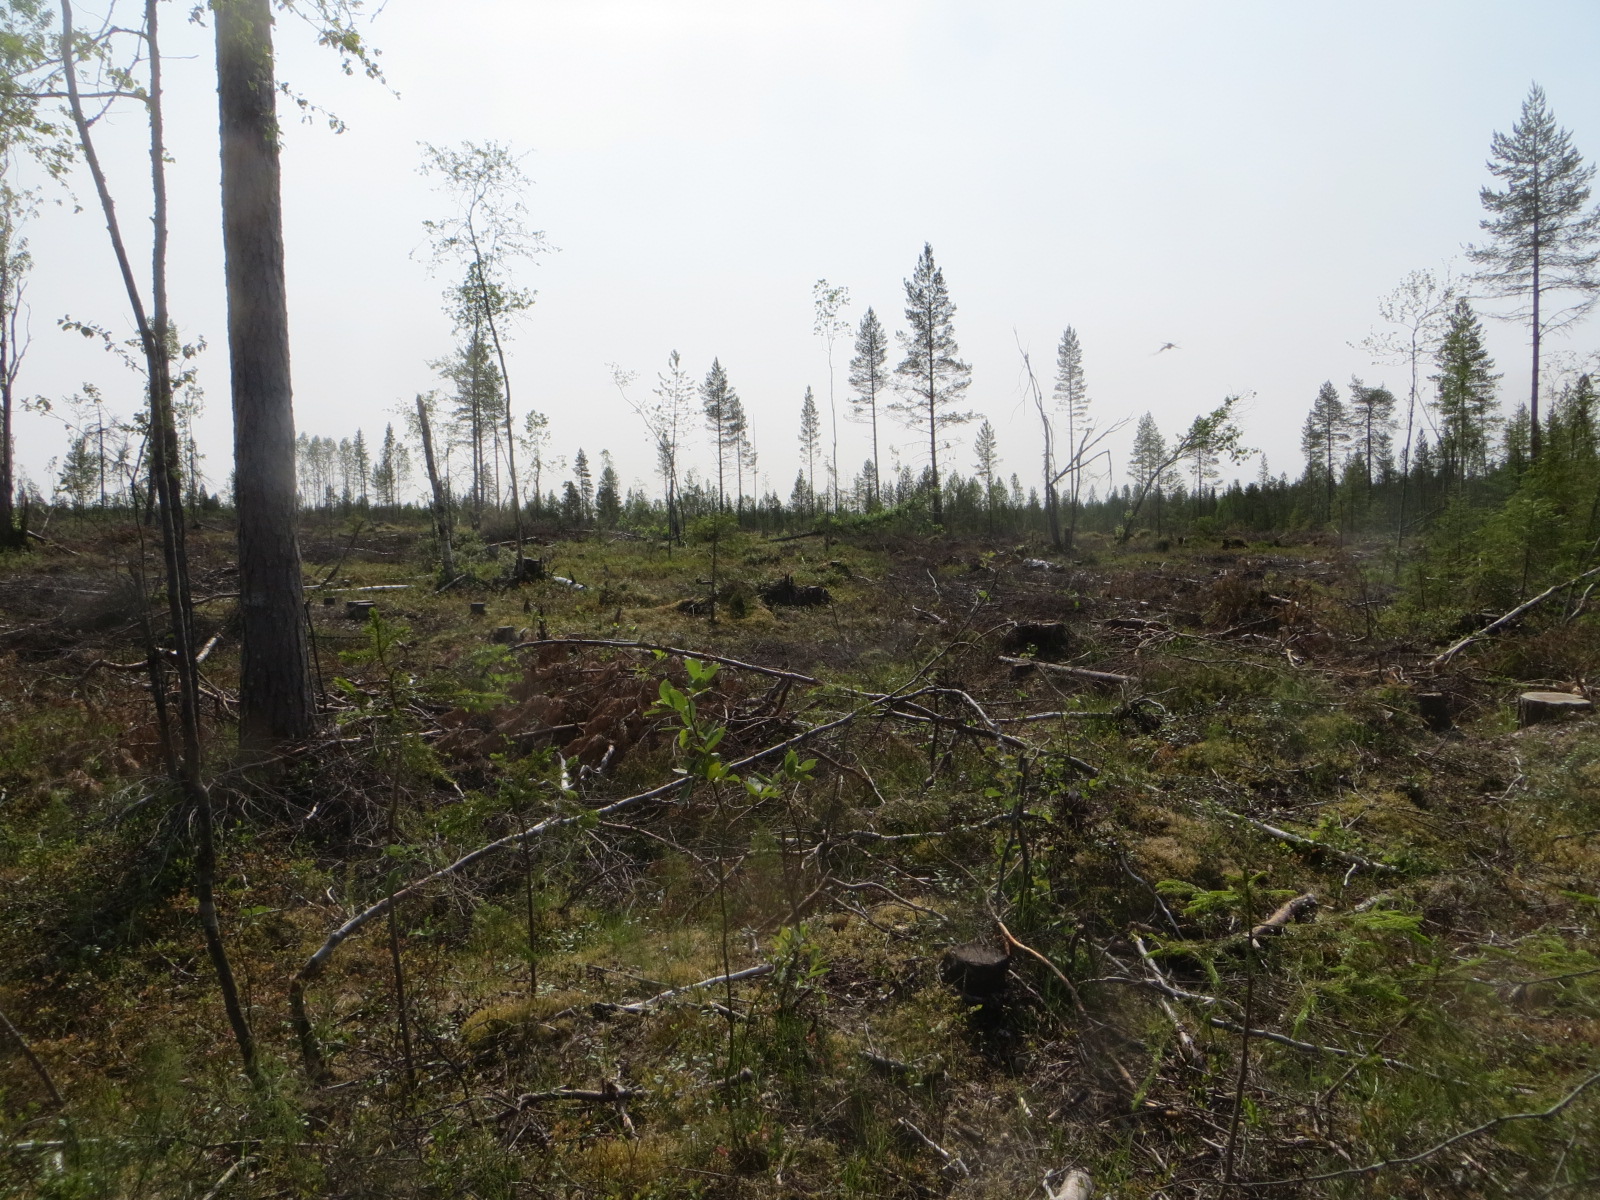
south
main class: Woodland
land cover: Pine dominated mixed woodland
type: boreal forest
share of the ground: 10 - 25 %
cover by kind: shrubs 45 %, lichens and mosses 45 %, coniferous forest trees 5 %, broadleaved forest trees 5 %
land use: Forestry
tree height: > 5 m
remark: Clear cut
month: July
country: FI
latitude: 65.8583
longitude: 25.6106
